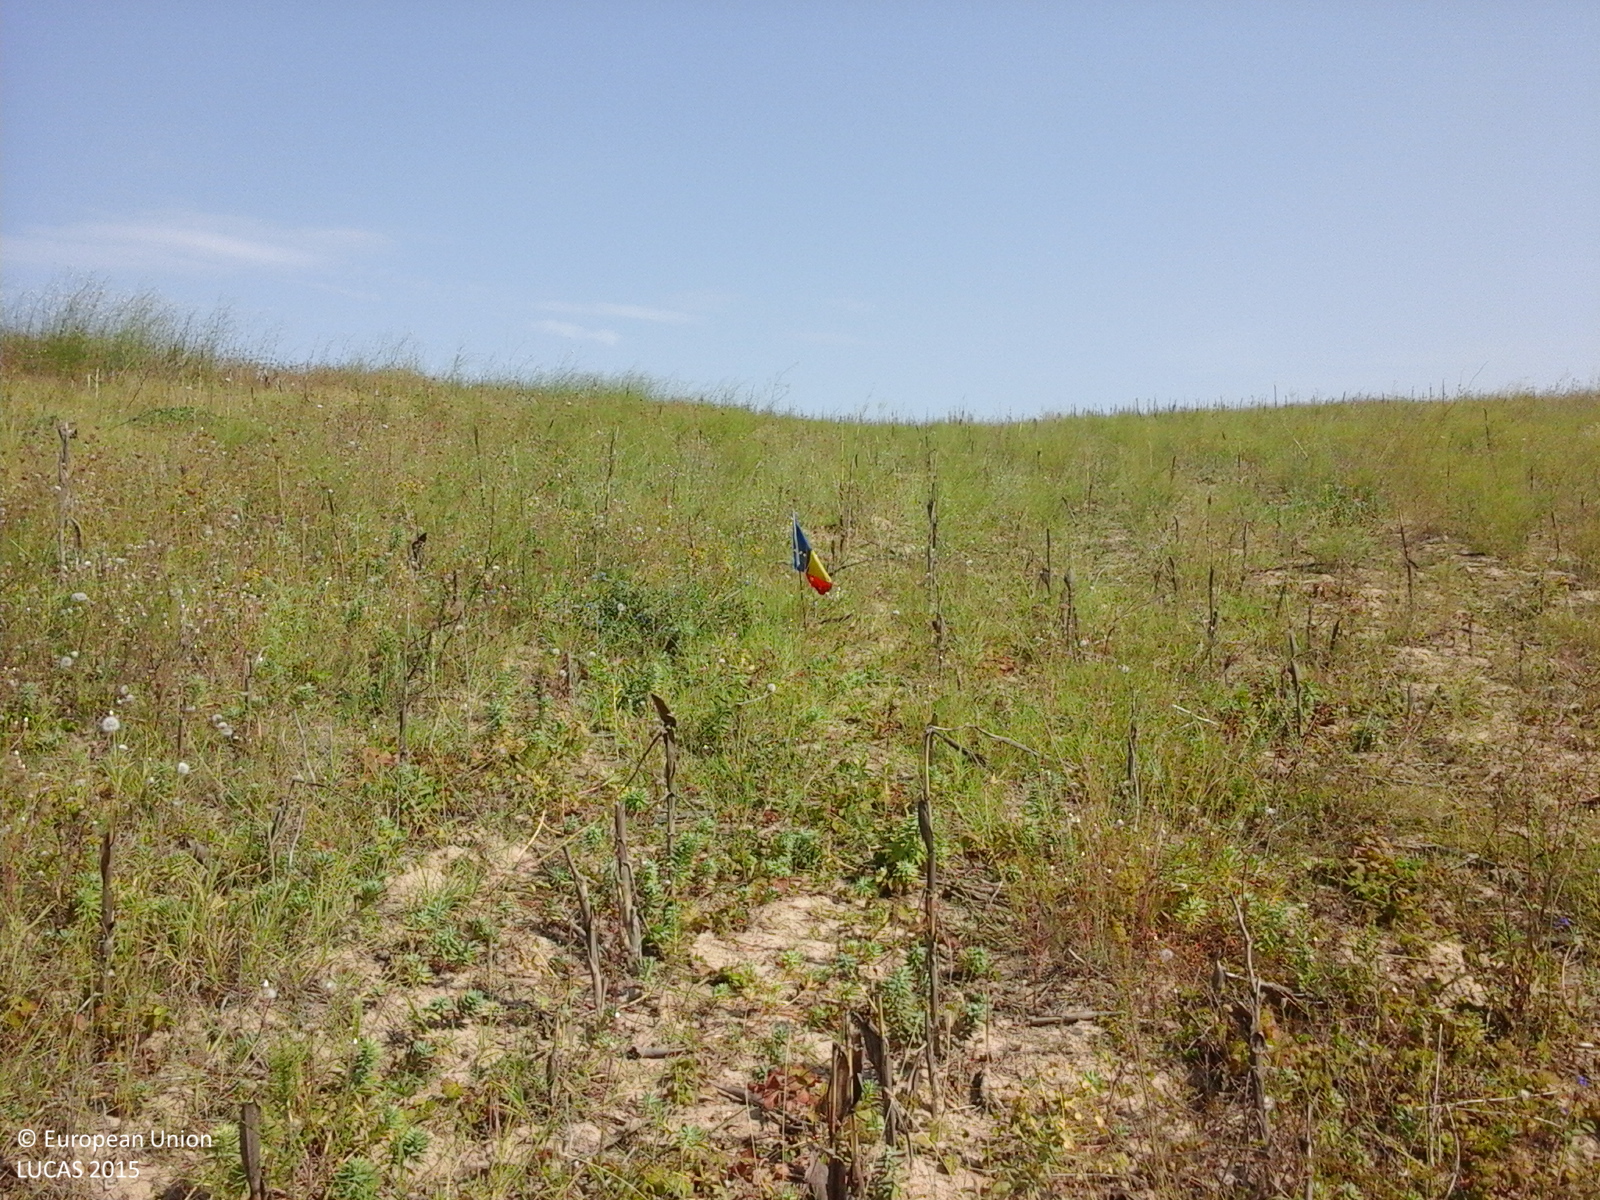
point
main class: Grassland
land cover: Spontaneously vegetated surfaces
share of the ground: 10 - 25 %
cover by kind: herbaceous plants 100 %
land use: Fallow land
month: August
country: RO
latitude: 44.1886
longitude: 27.9554
